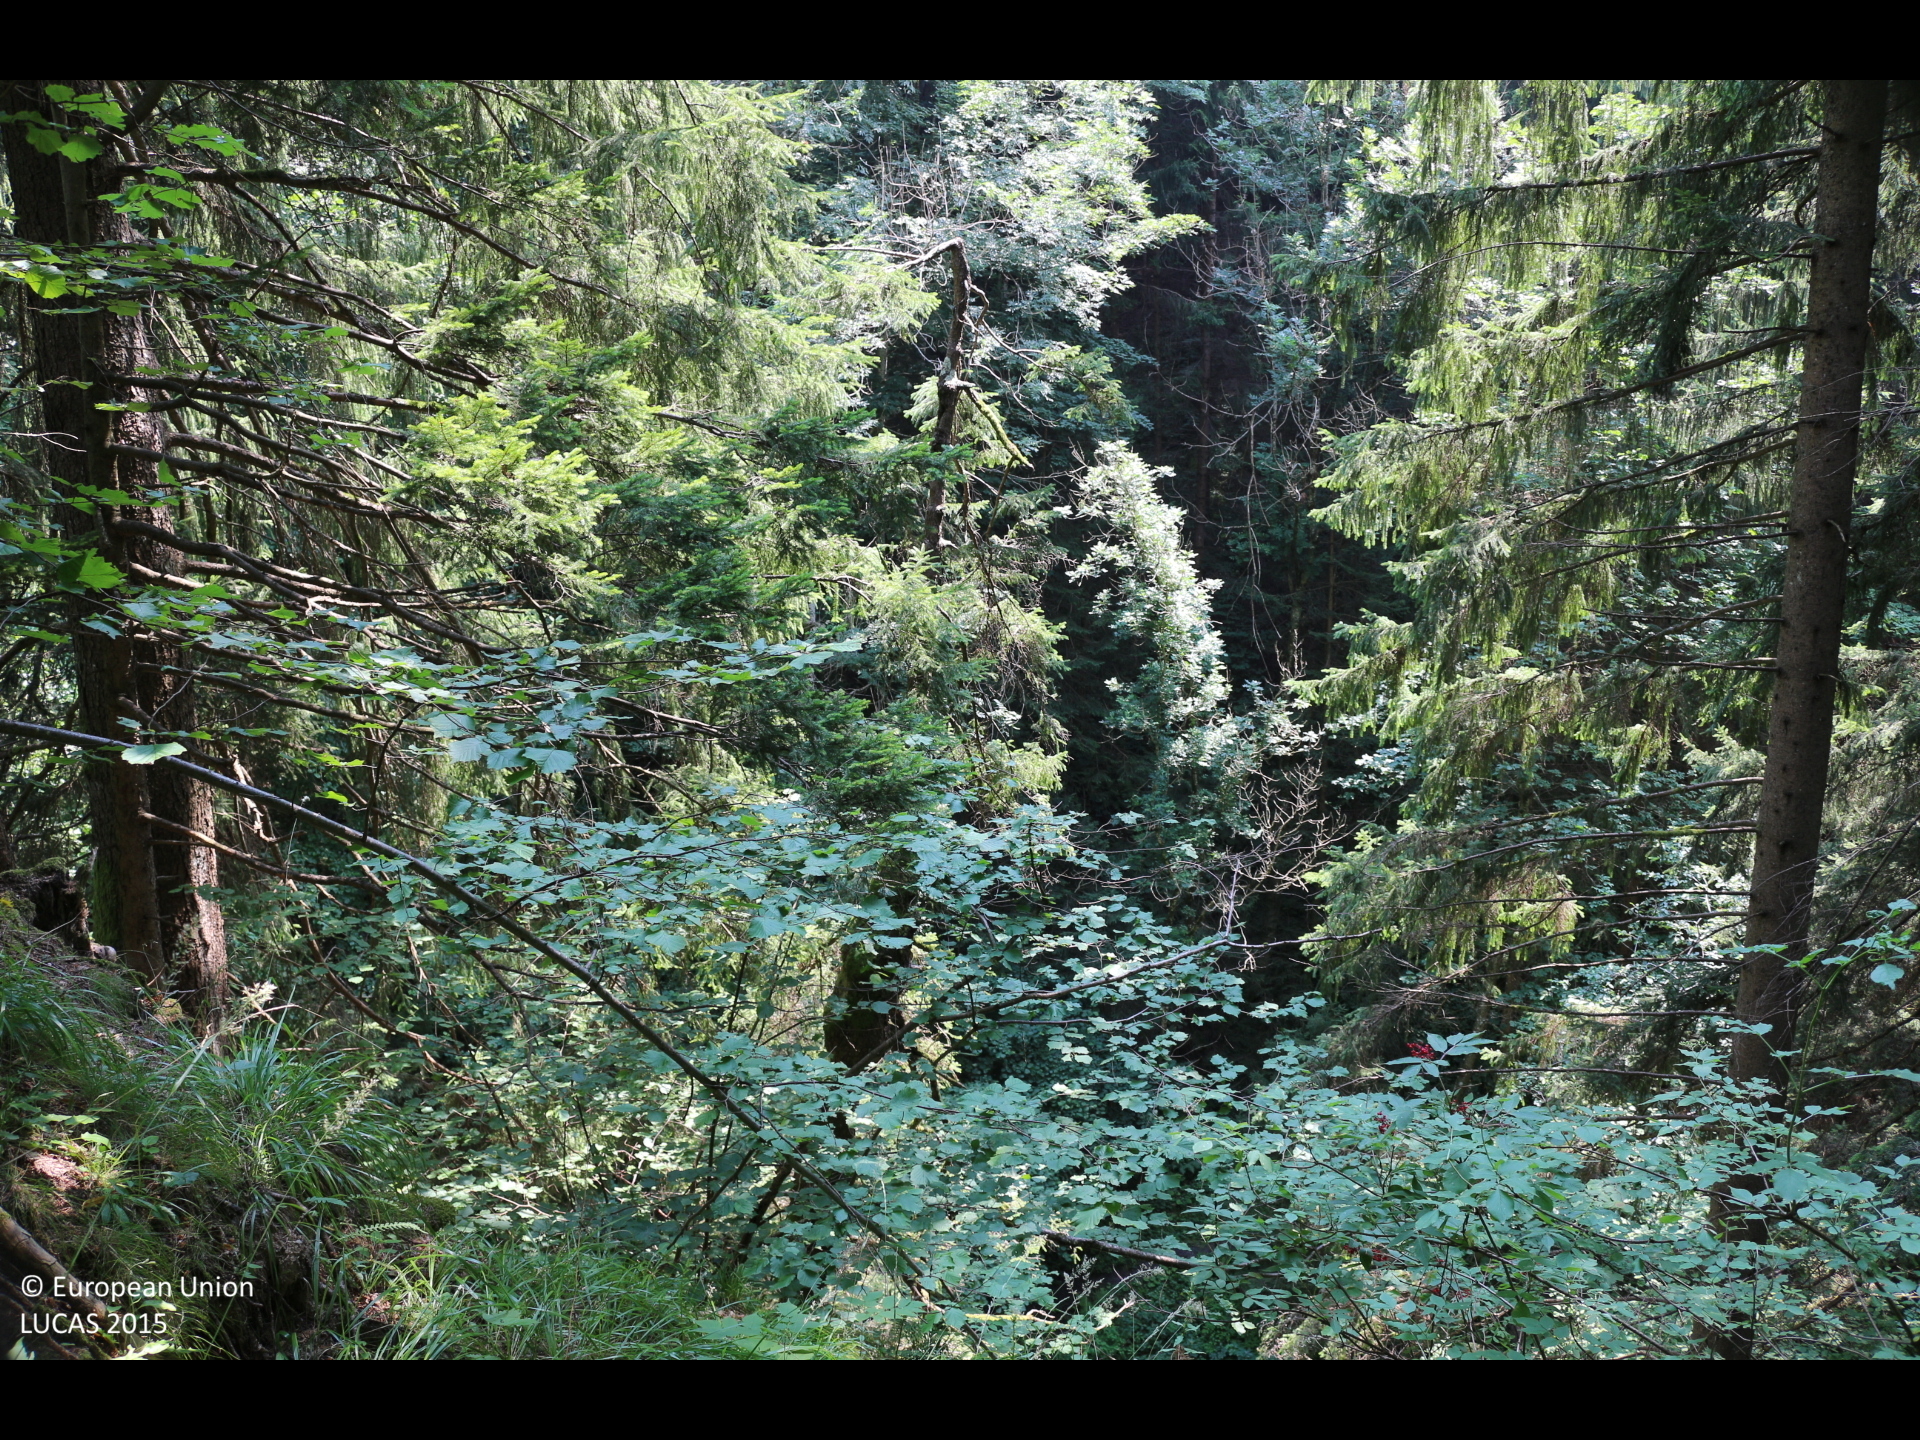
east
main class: Woodland
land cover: Spruce dominated mixed woodland
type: alpine coniferous forest
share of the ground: > 75 %
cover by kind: coniferous forest trees 60 %, broadleaved forest trees 35 %, herbaceous plants 5 %
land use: Forestry
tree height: > 5 m
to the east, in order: Spruce dominated mixed woodland; Rivers and streams; Broadleaved woodland; Rocks and stones; Spruce dominated mixed woodland; Spruce dominated coniferous woodland; Fences; Spruce dominated coniferous woodland; Tracks; Spruce dominated coniferous woodland; Grassland with sparse tree/shrub cover; Grassland without tree/shrub cover; Rock outcrops; Grassland without tree/shrub cover; Rocks and stones; Grassland with sparse tree/shrub cover
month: July
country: AT
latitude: 46.8134
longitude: 13.6015
